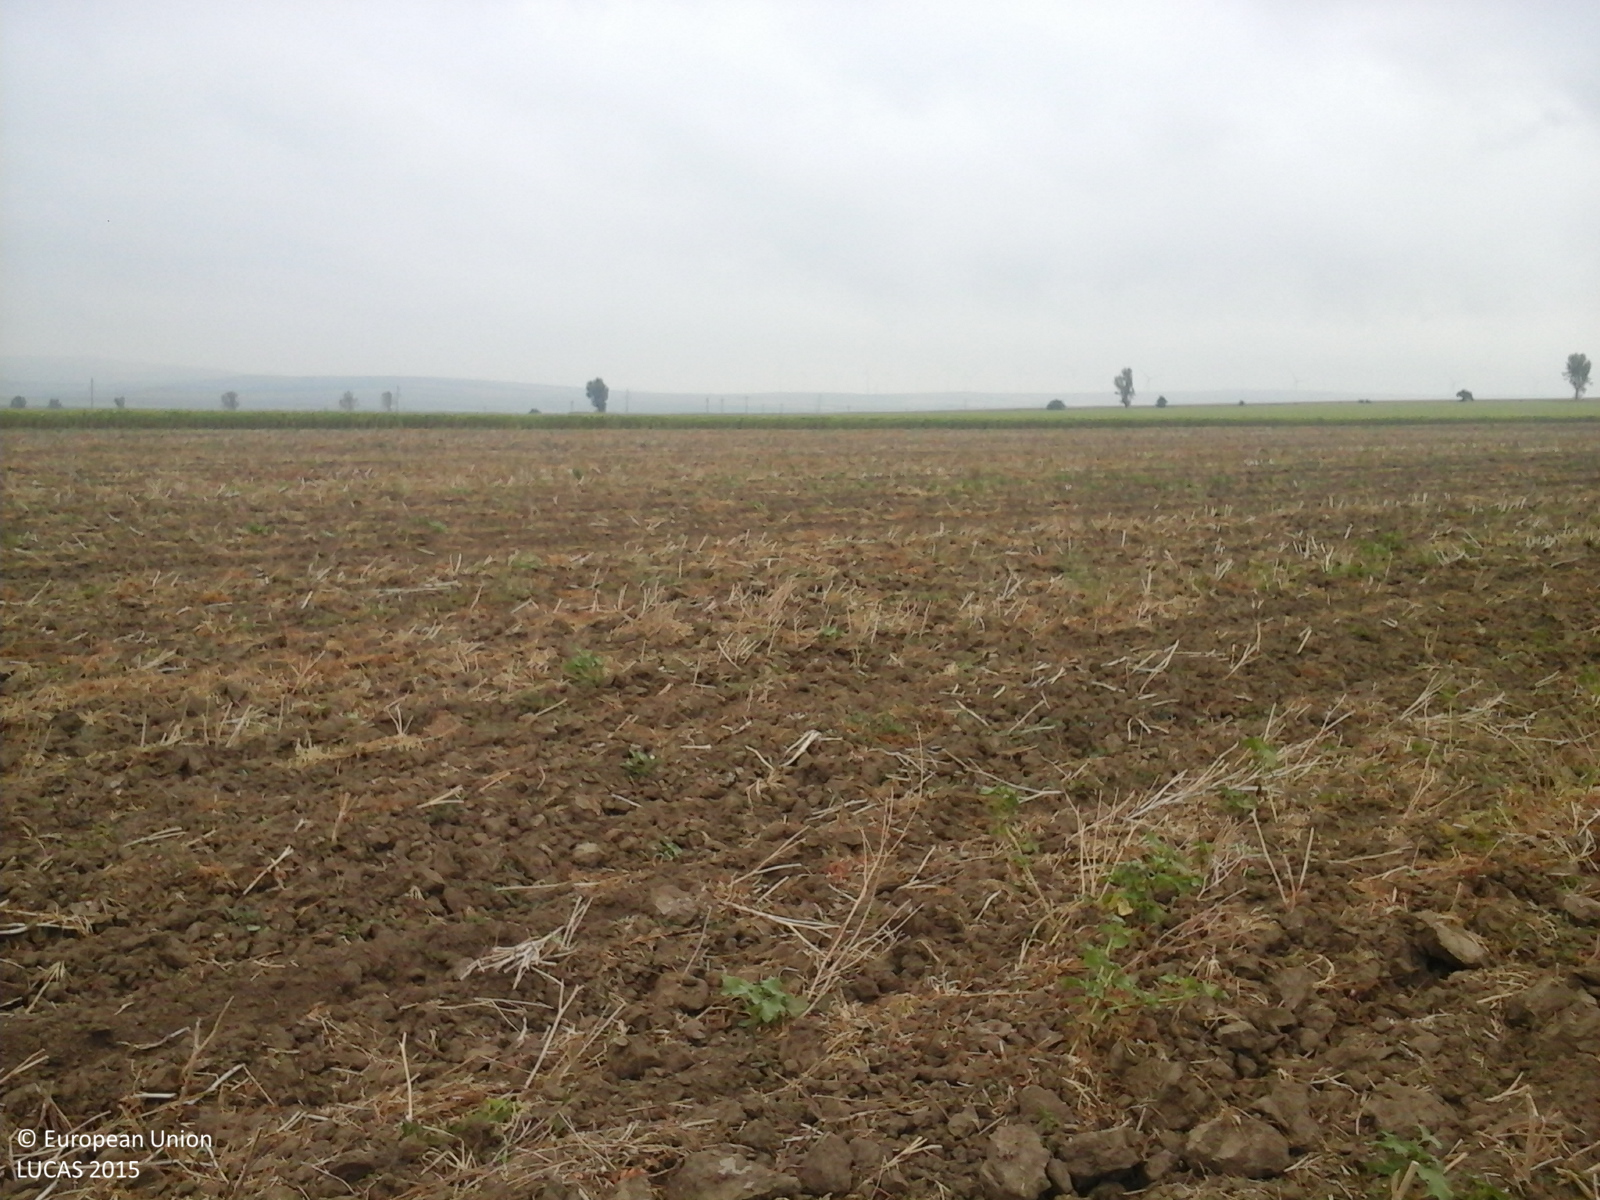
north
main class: Cropland
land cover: Rape and turnip rape
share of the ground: 10 - 25 %
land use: Agriculture (excluding fallow land and kitchen gardens)
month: August
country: RO
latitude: 44.8467
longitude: 28.3020
